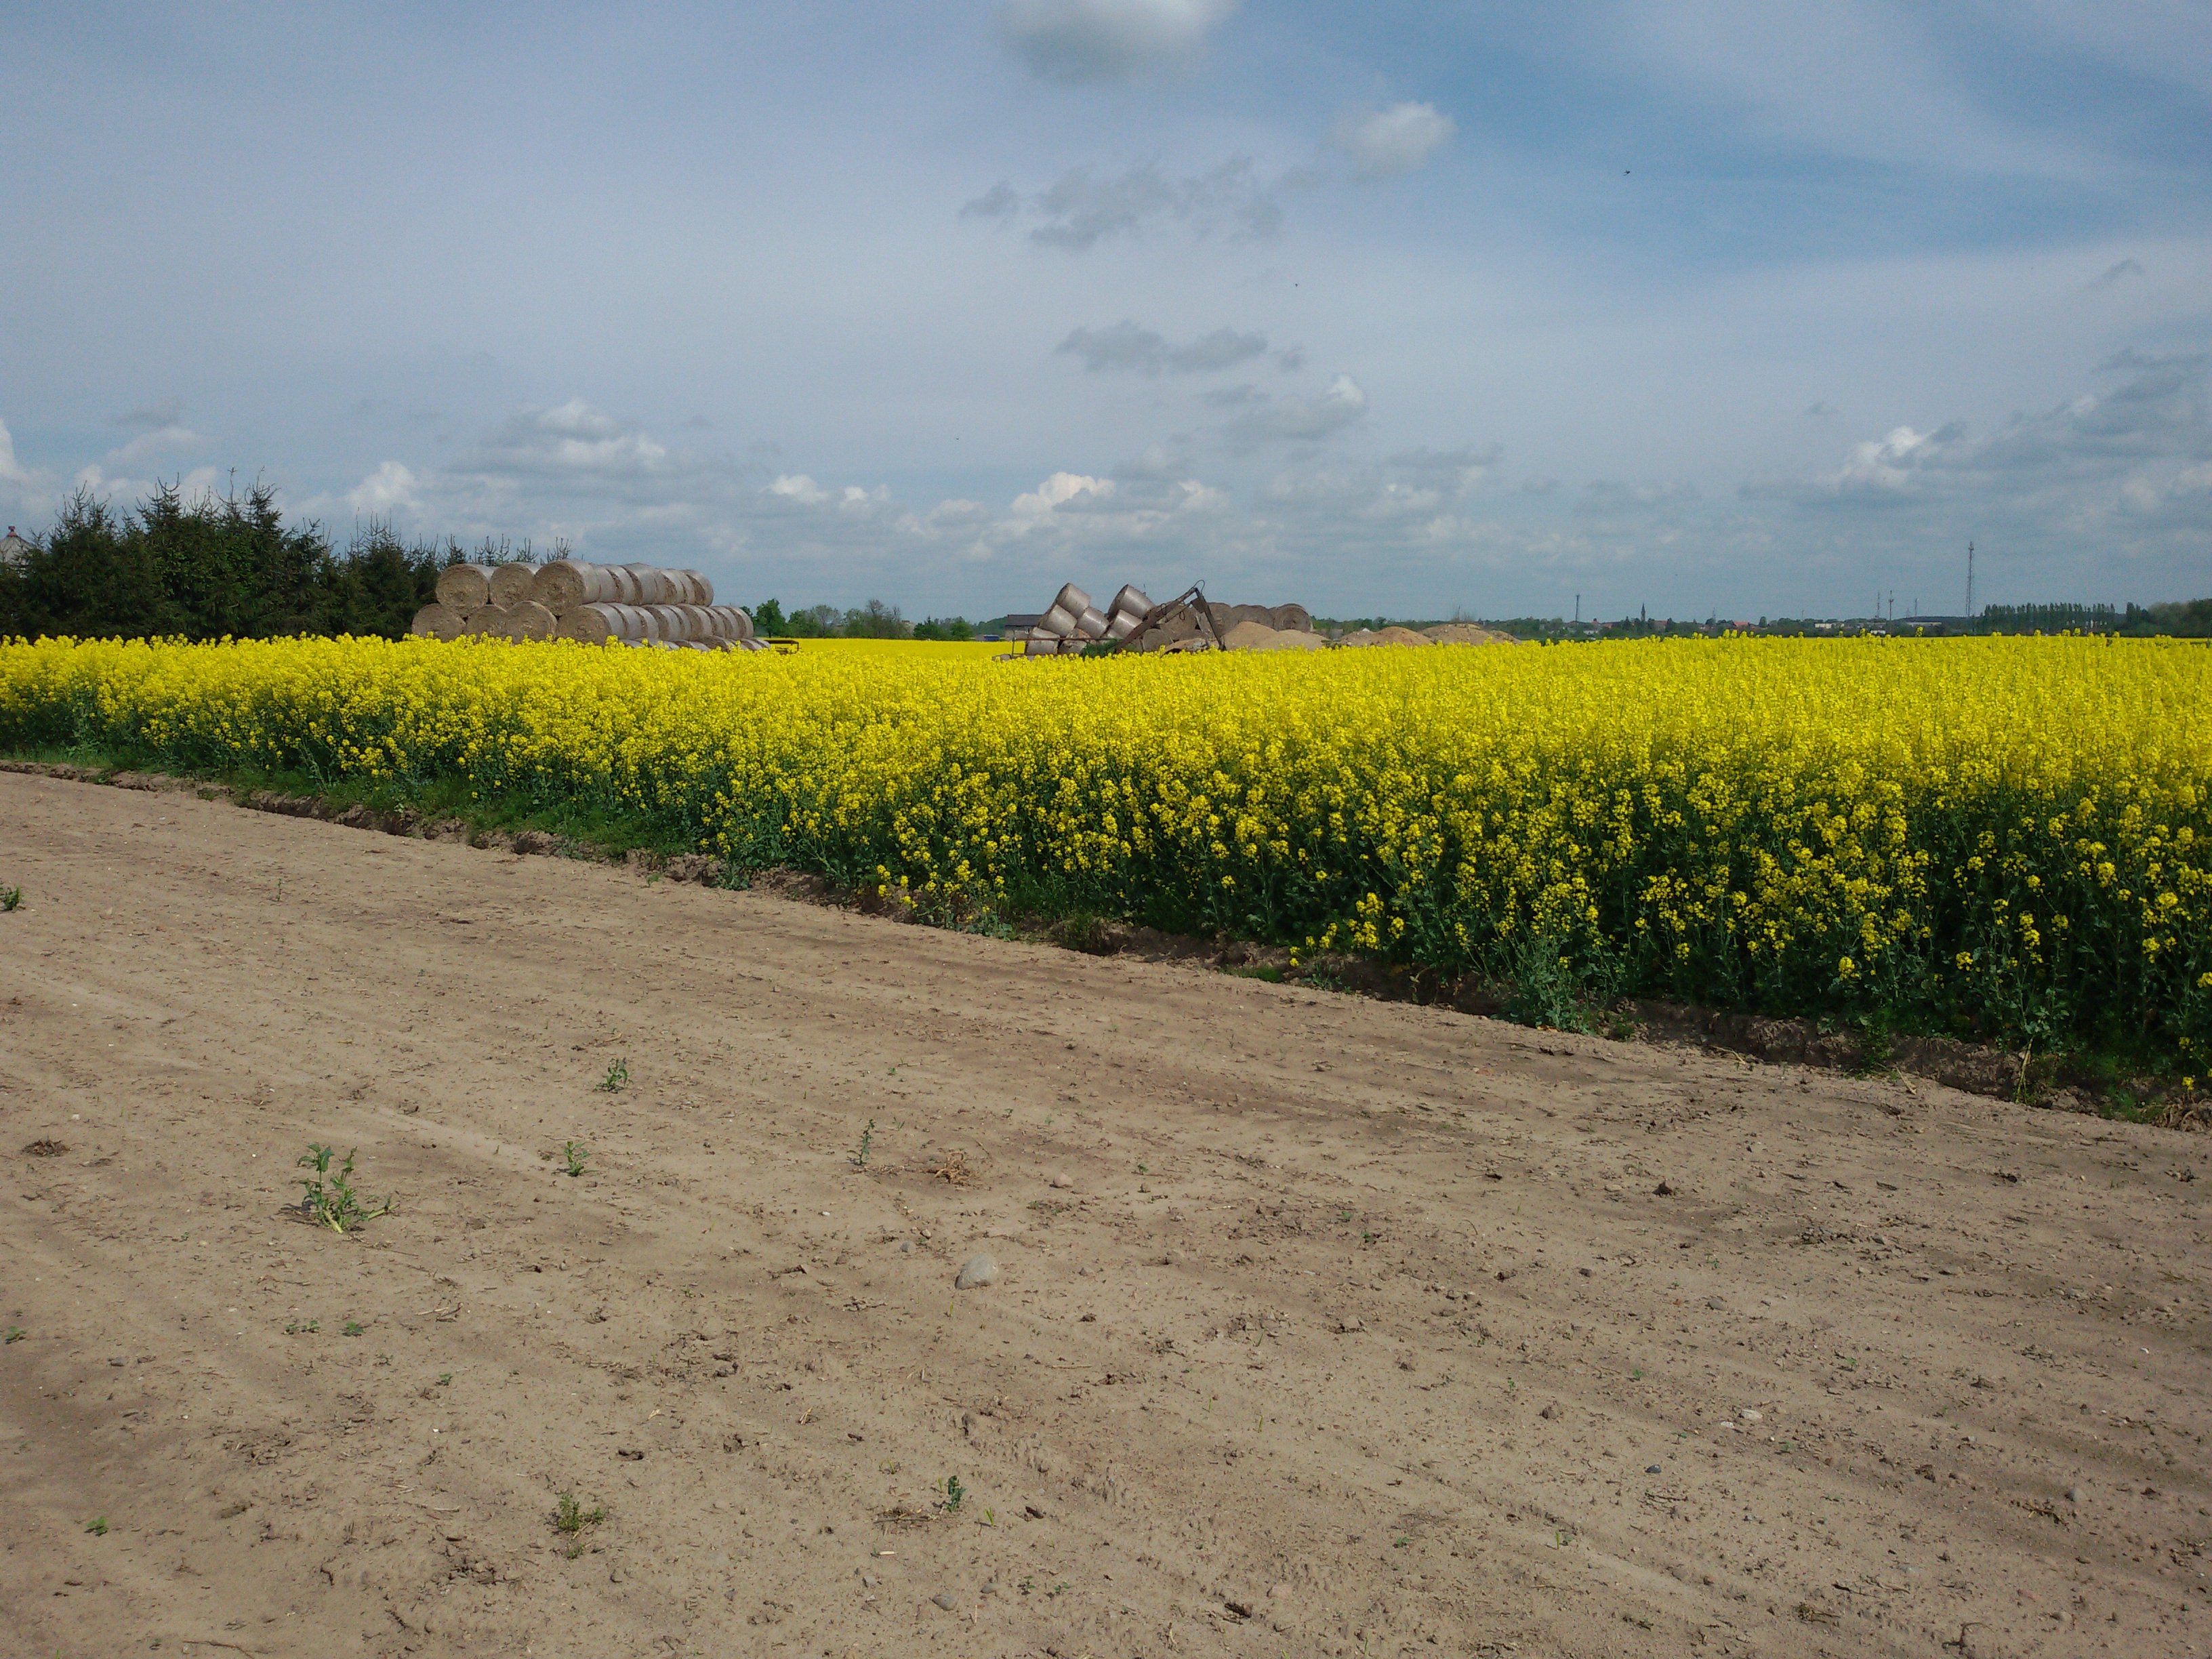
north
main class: Cropland
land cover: Common wheat
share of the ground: < 10 %
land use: Agriculture (excluding fallow land and kitchen gardens)
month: May
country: PL
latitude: 52.4841
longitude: 16.2353
